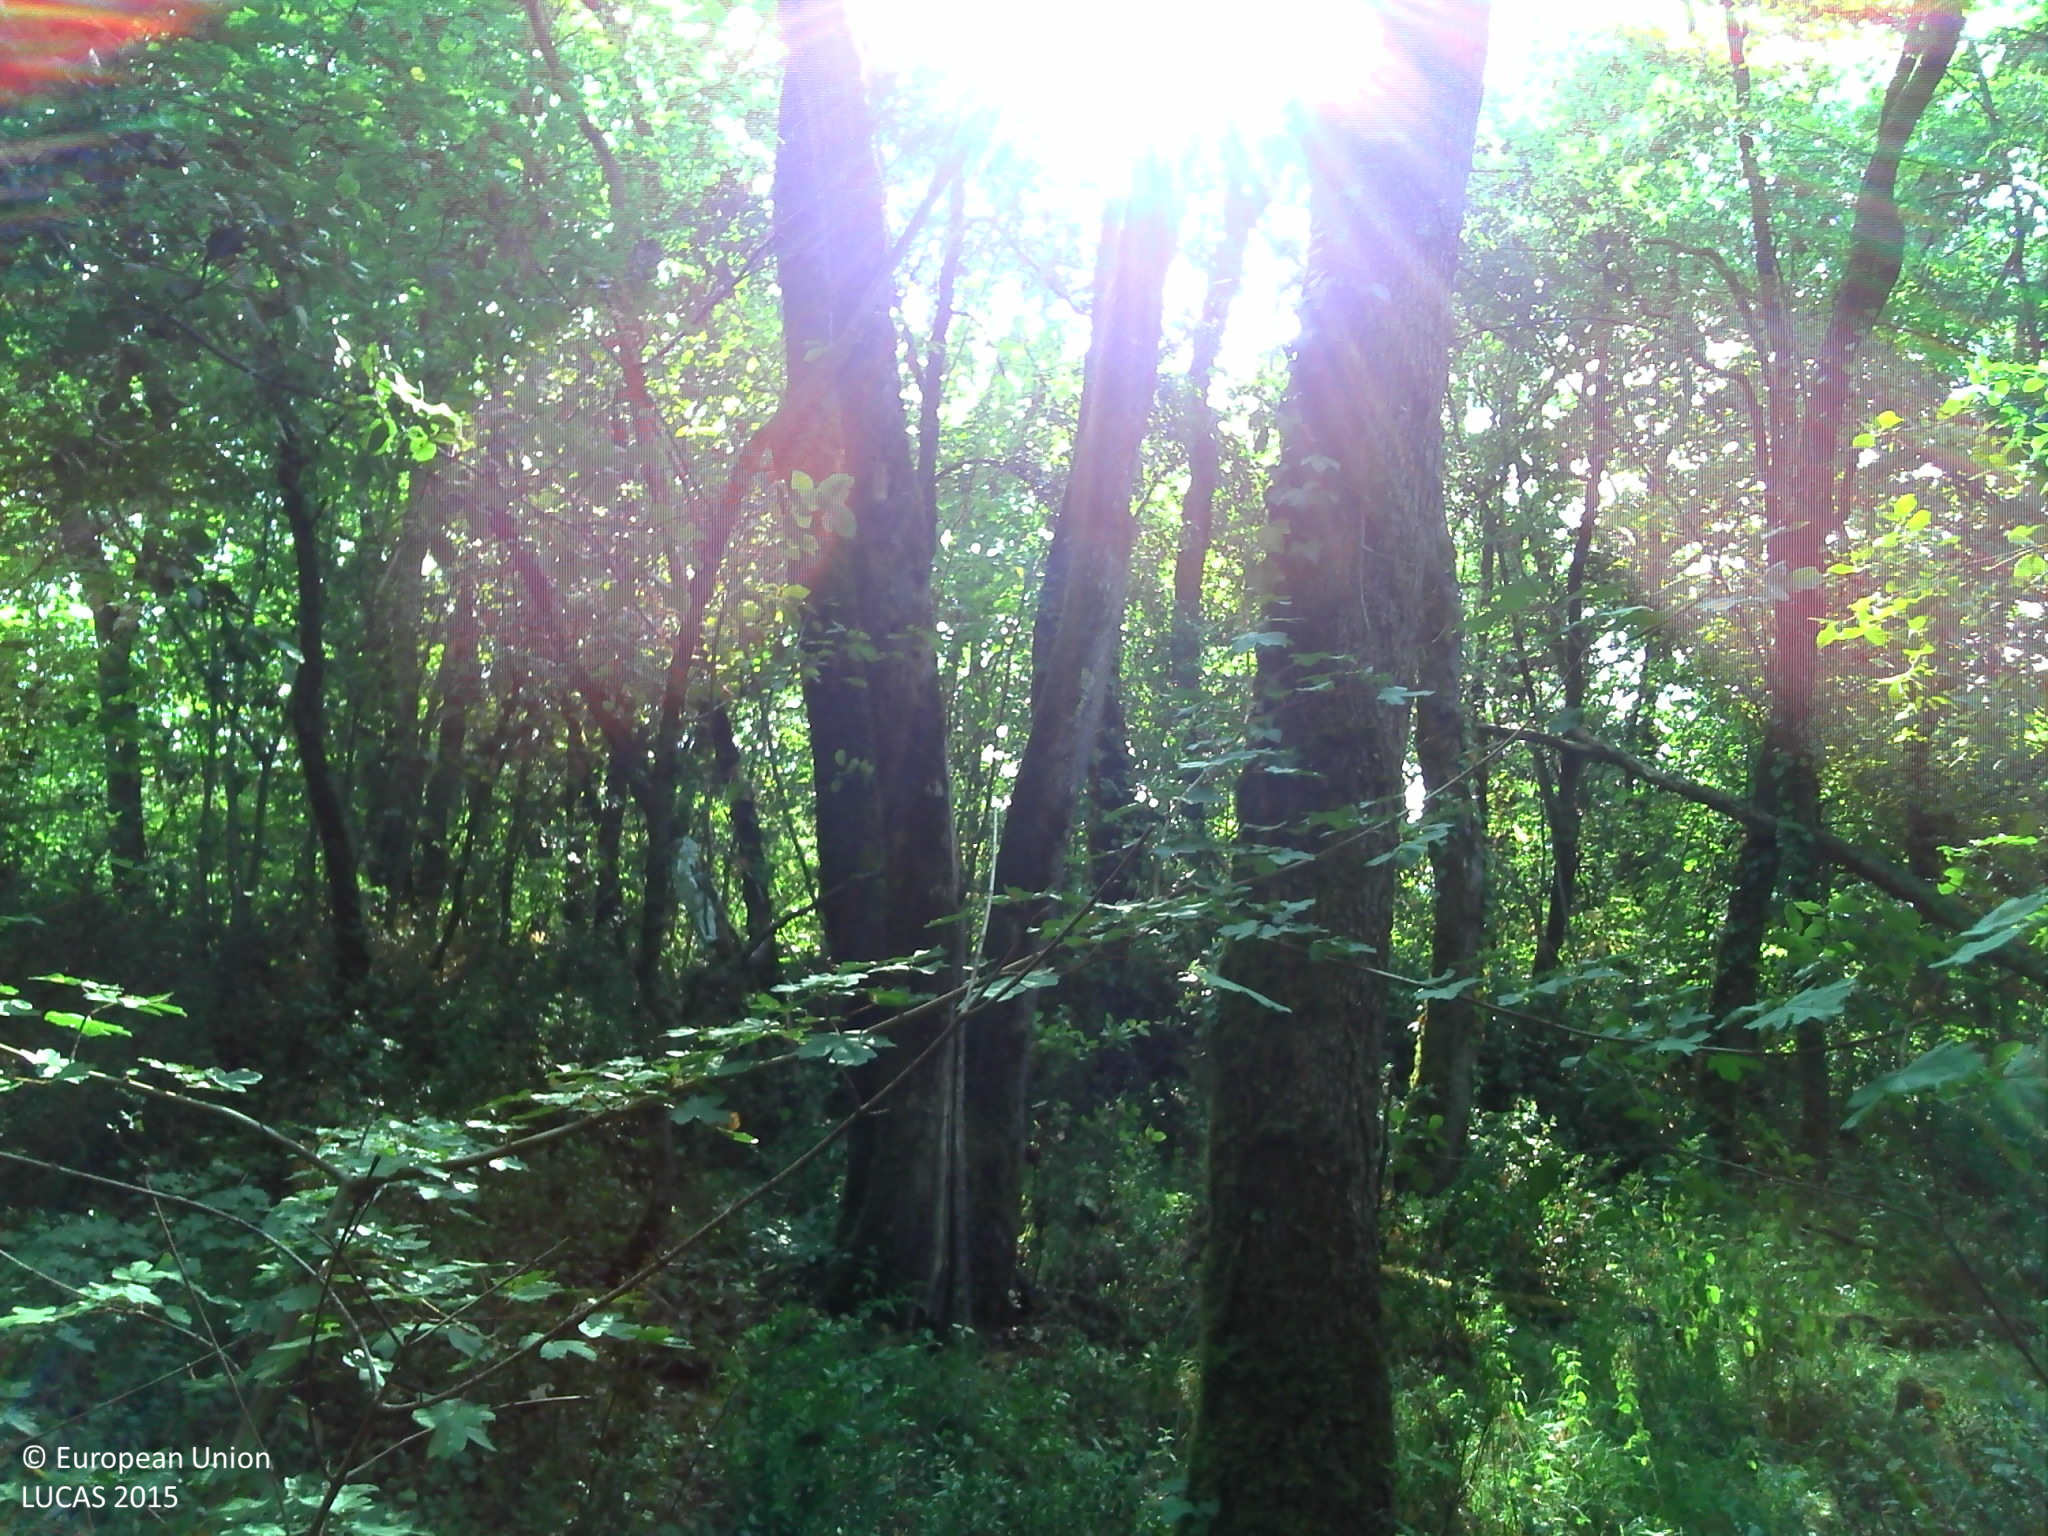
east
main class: Woodland
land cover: Broadleaved woodland
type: acidophilous oak and oak-birch forest
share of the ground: > 75 %
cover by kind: broadleaved forest trees 80 %, herbaceous plants 10 %, lichens and mosses 10 %
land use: Forestry
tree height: > 5 m
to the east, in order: Broadleaved woodland; Tracks; Broadleaved woodland
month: August
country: FR
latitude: 44.8308
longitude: 1.2296
